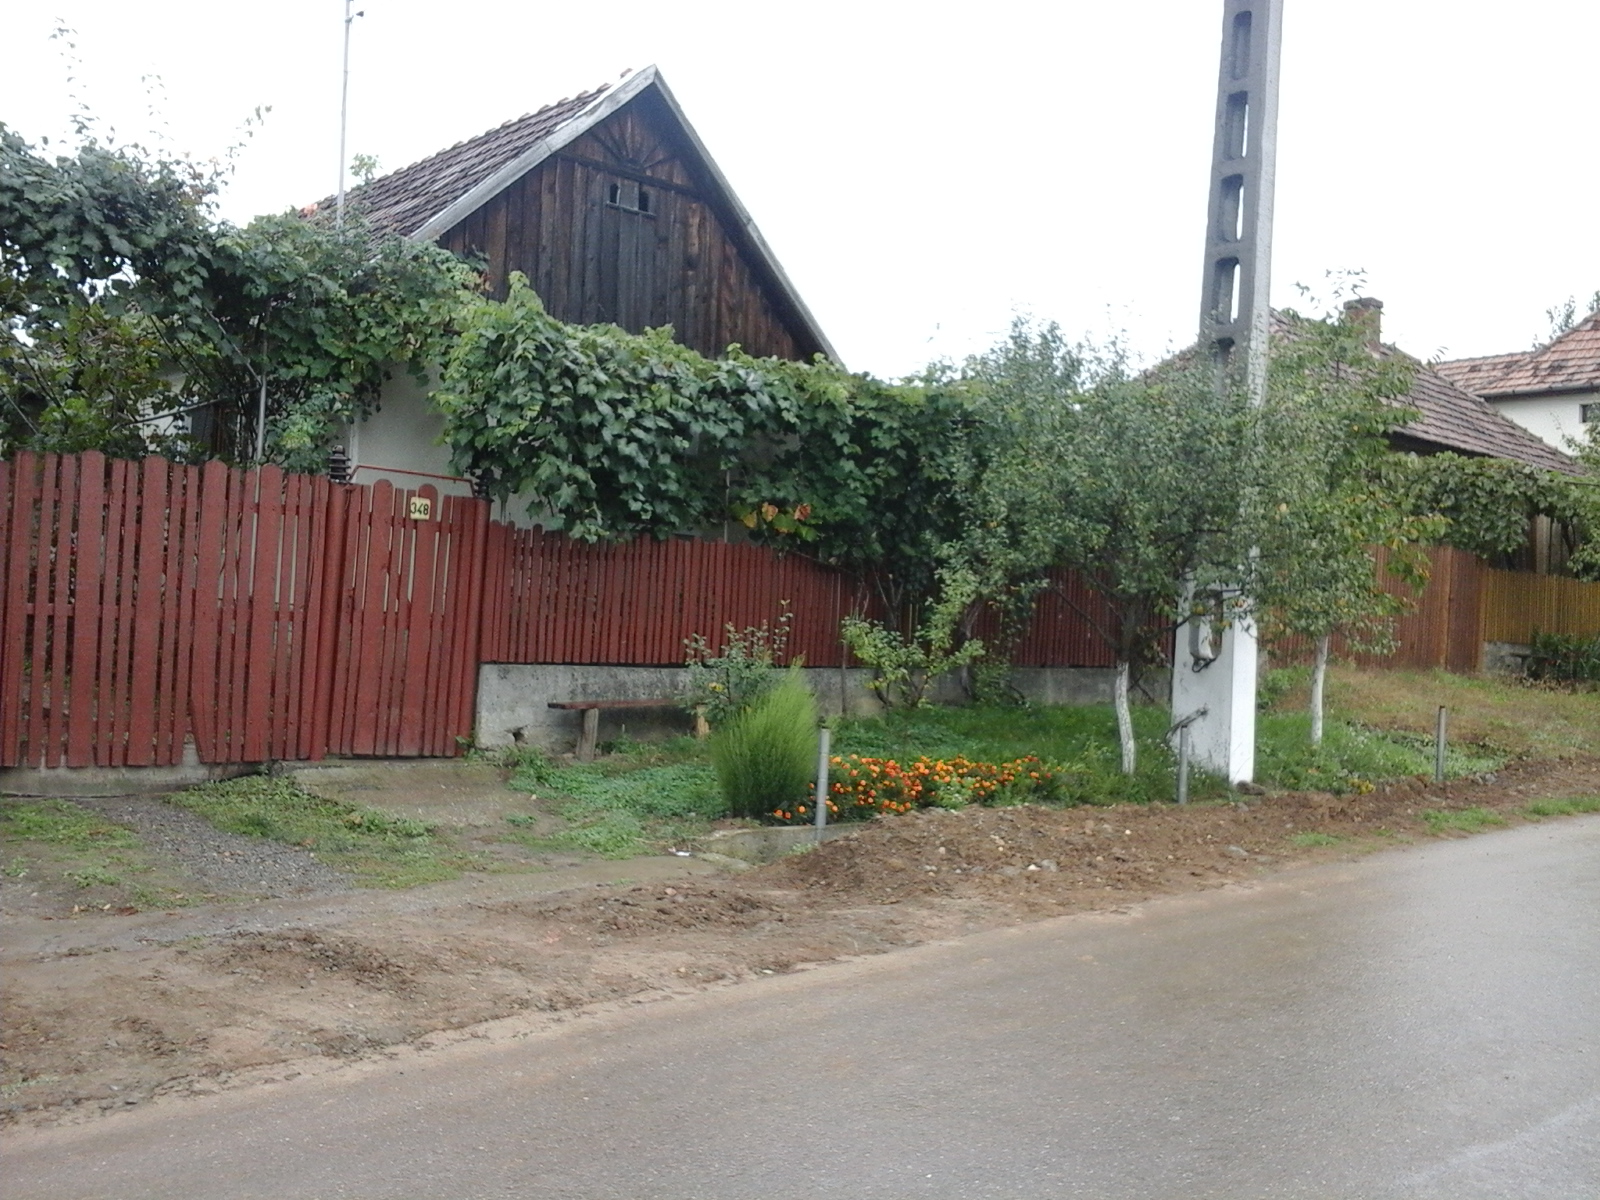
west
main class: Cropland
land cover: Maize
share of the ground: > 75 %
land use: Agriculture (excluding fallow land and kitchen gardens)
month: September
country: RO
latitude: 47.2105
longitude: 22.5596
